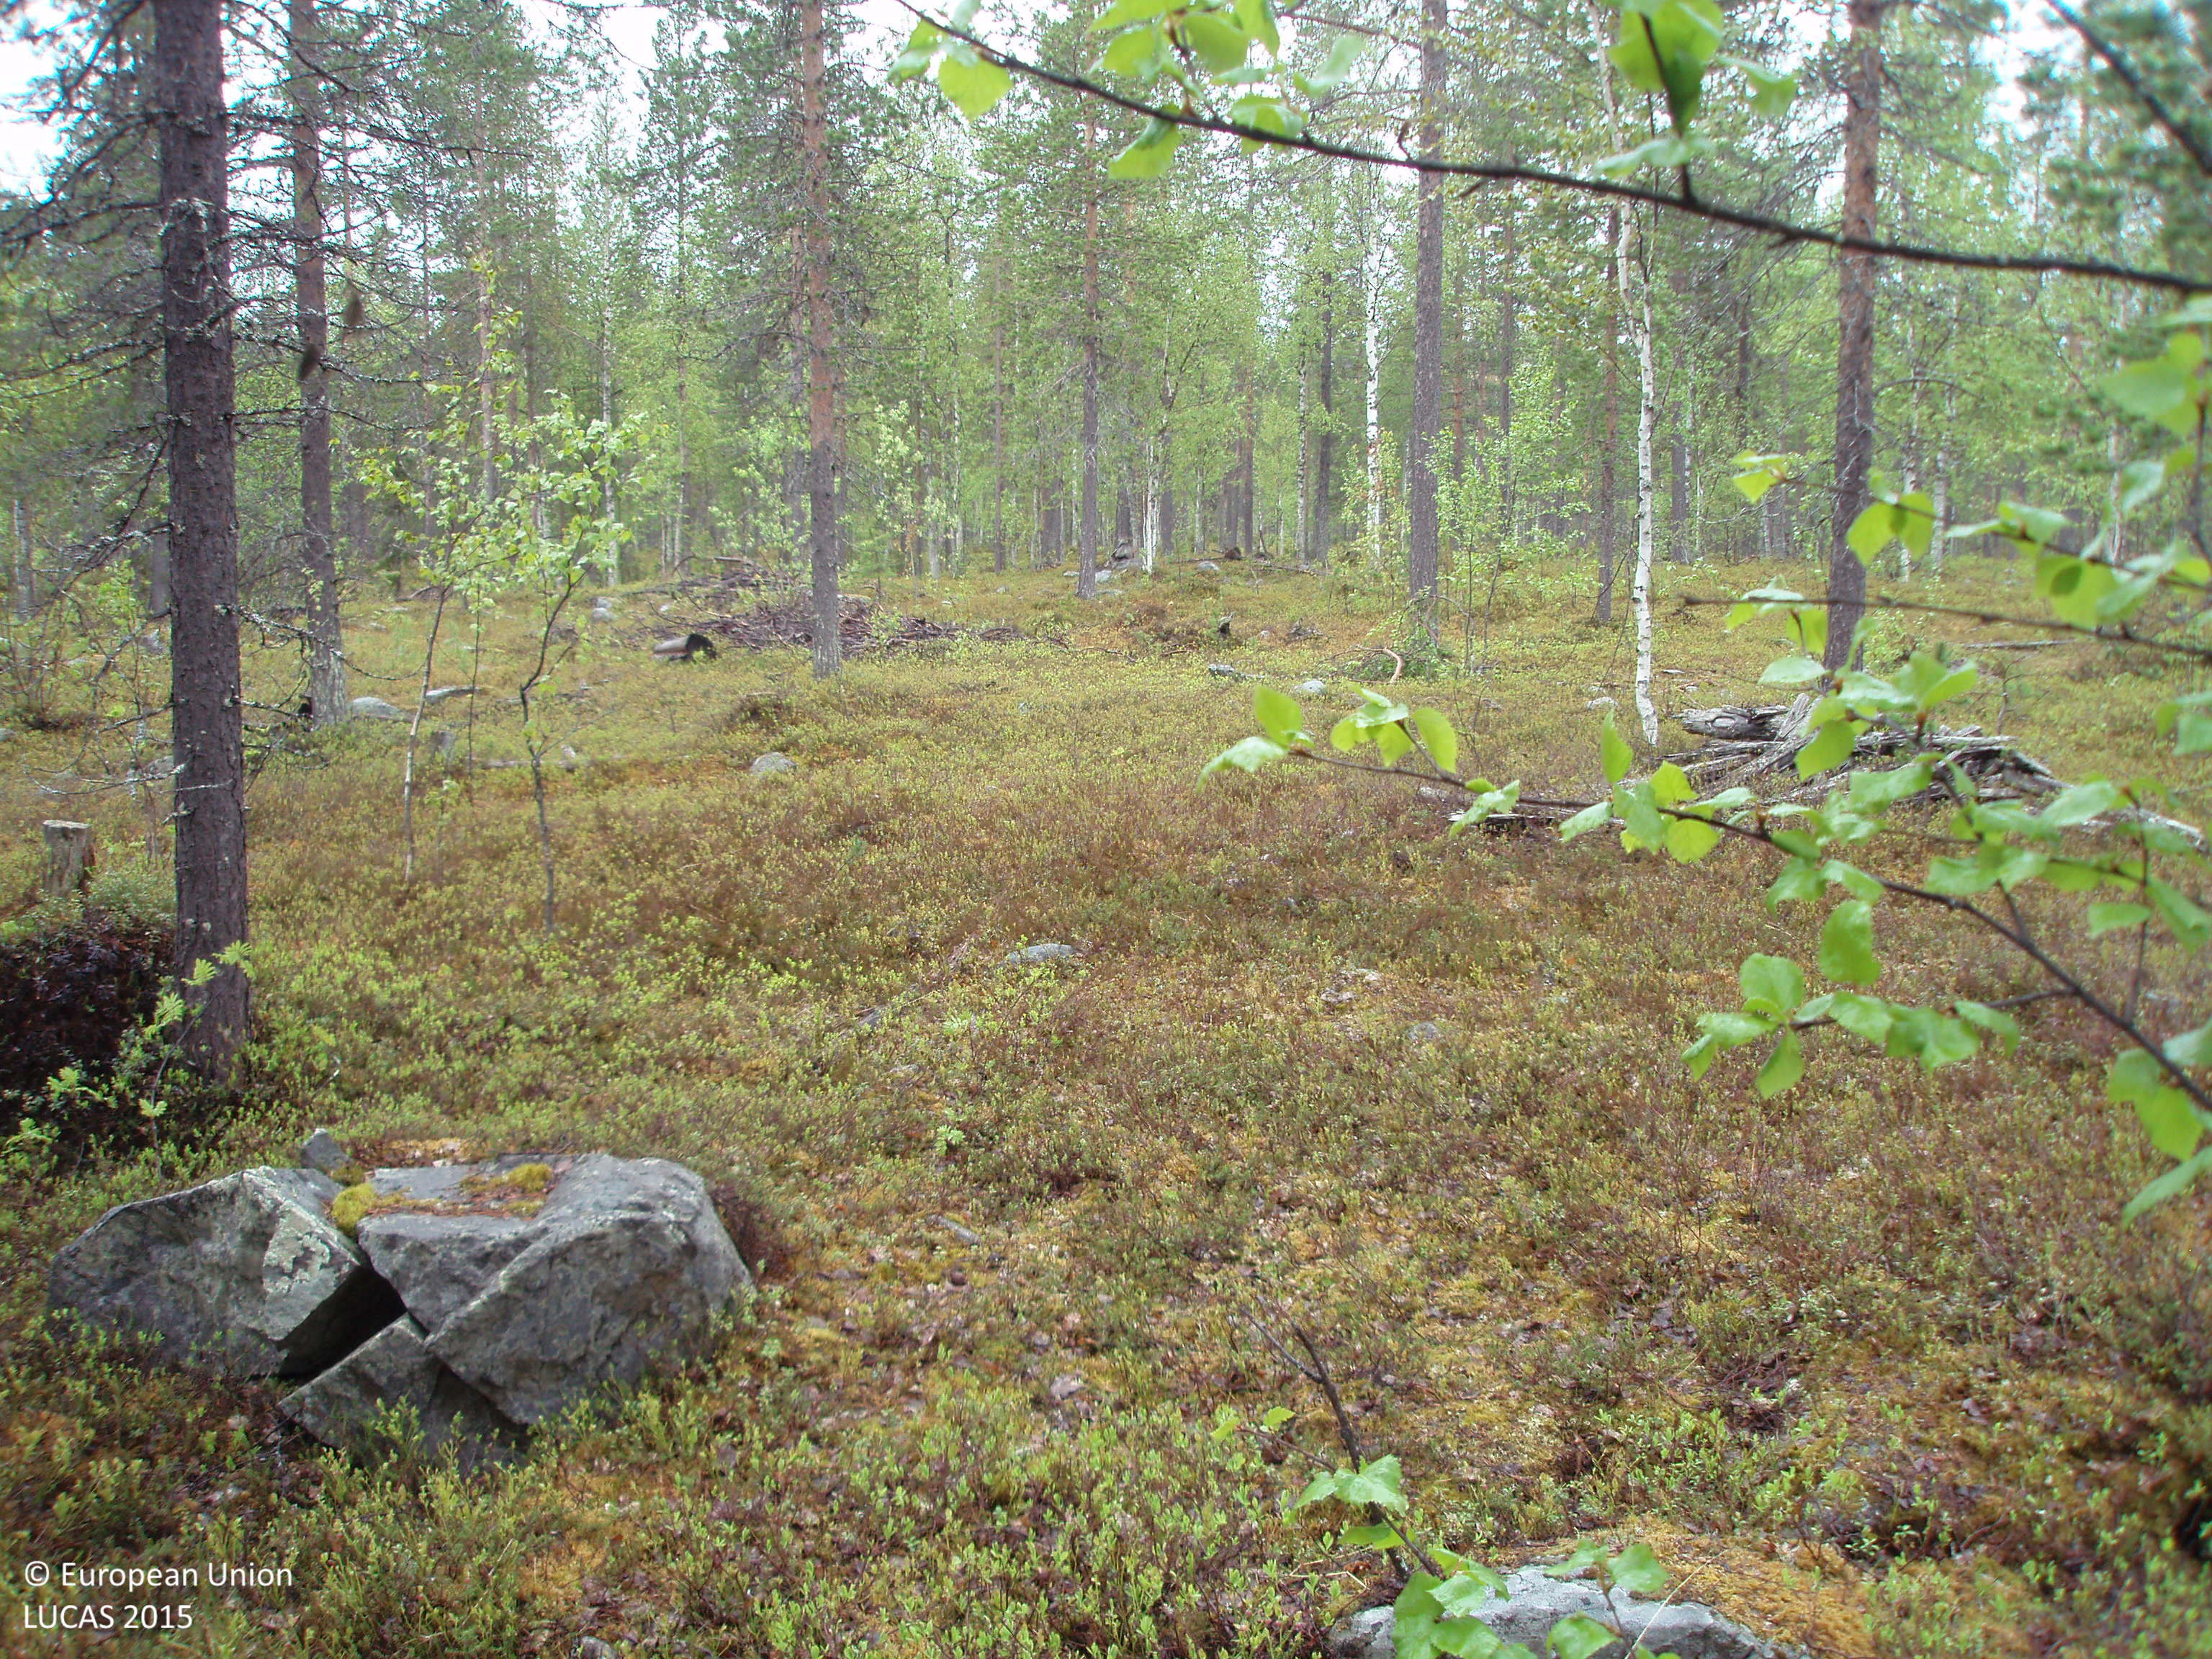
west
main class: Woodland
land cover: Pine dominated mixed woodland
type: boreal forest
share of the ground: 50 - 75 %
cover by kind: coniferous forest trees 35 %, shrubs 35 %, broadleaved forest trees 30 %
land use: Forestry
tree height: > 5 m
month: June
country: FI
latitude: 67.6081
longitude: 26.3682
